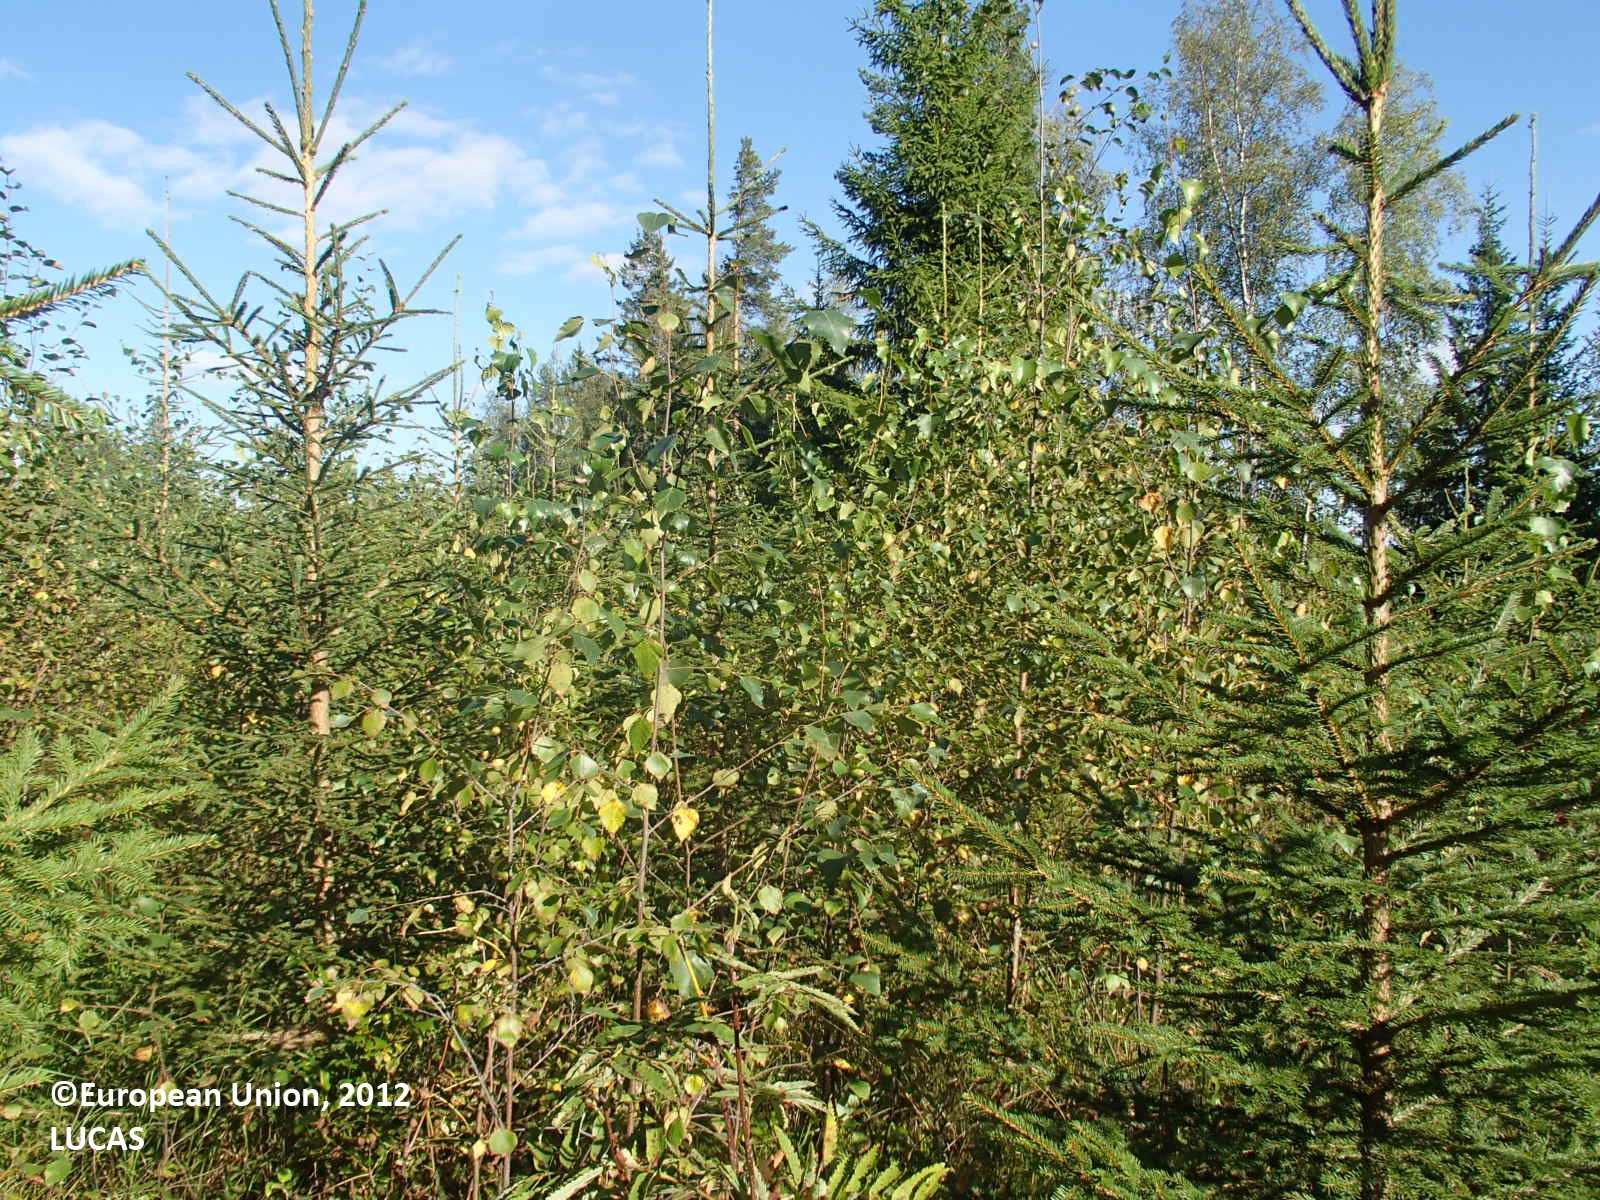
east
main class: Woodland
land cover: Spruce dominated mixed woodland
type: boreal forest
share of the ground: > 75 %
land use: Forestry
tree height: < 5 m
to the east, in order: Spruce dominated mixed woodland; Pine dominated mixed woodland; Spruce dominated mixed woodland; Ditches and canals; Spruce dominated mixed woodland
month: August
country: FI
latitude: 63.5529
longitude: 27.8982
